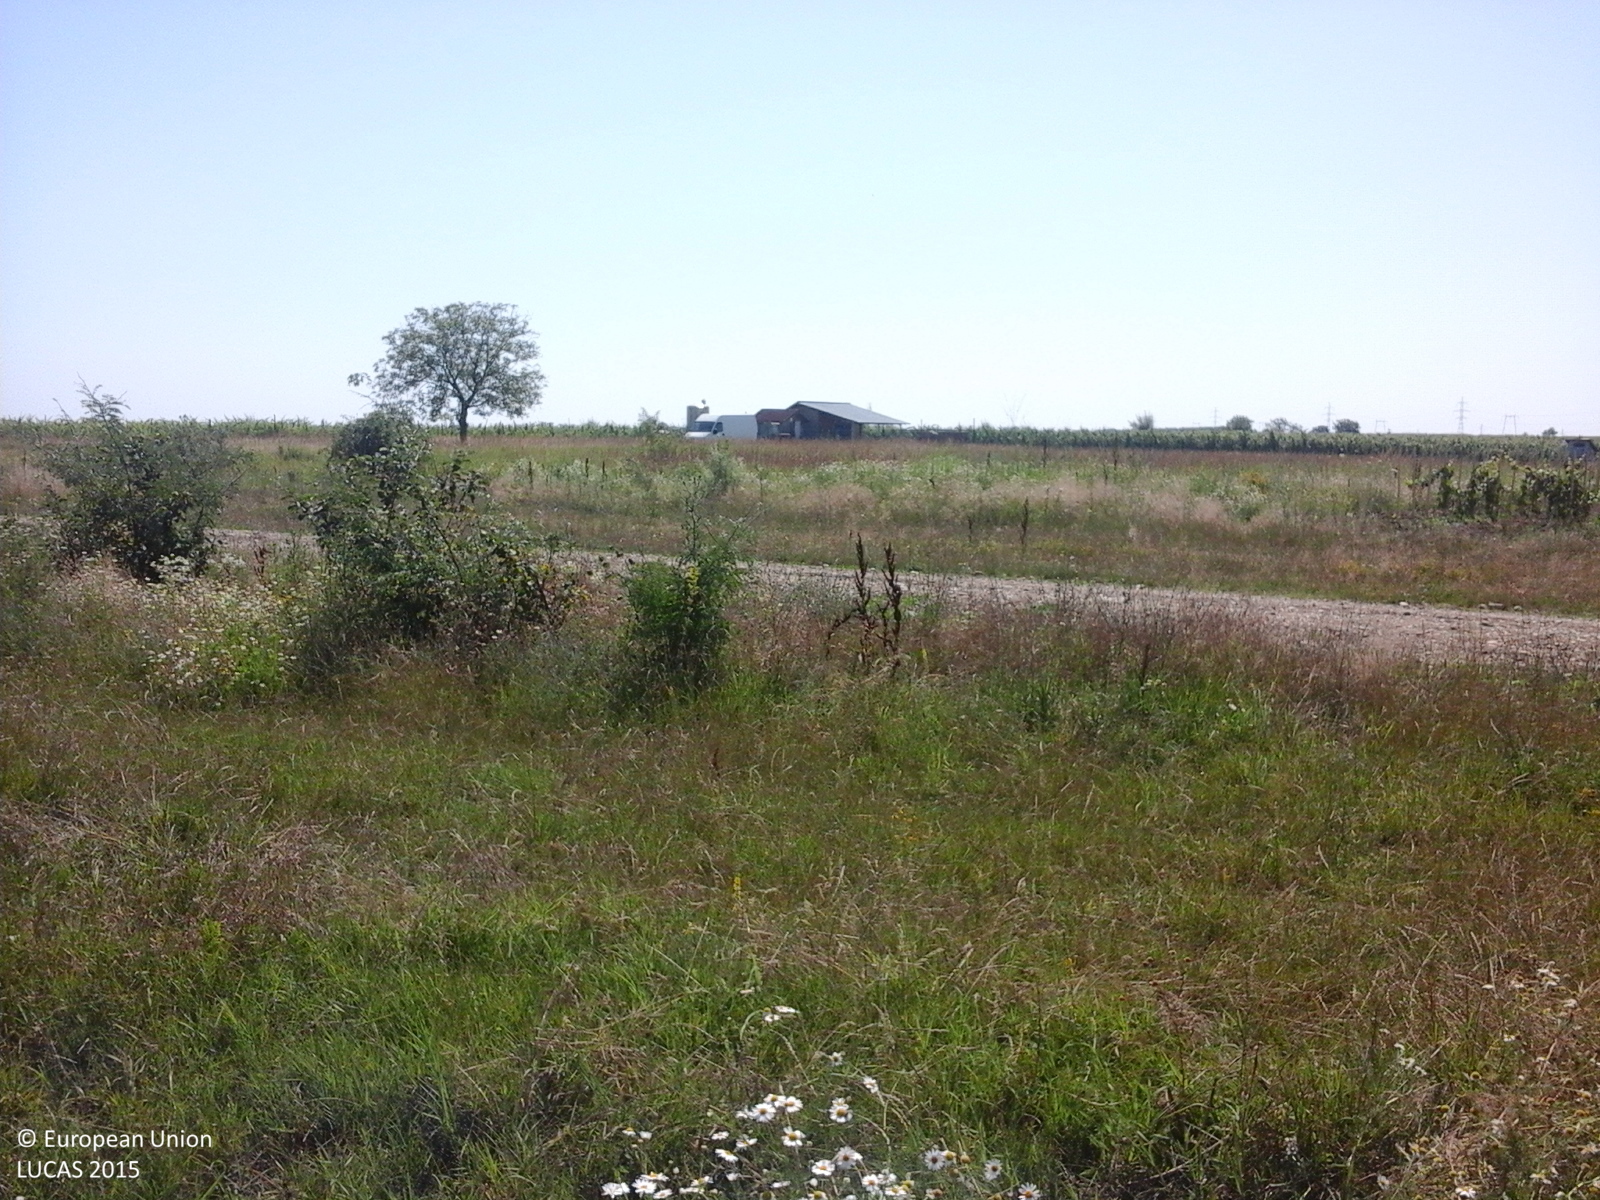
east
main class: Grassland
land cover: Spontaneously vegetated surfaces
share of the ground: > 75 %
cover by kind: herbaceous plants 100 %
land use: Agriculture (excluding fallow land and kitchen gardens)
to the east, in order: Spontaneously vegetated surfaces; Tracks; Spontaneously vegetated surfaces; Single bushes/trees; Tracks; Spontaneously vegetated surfaces; Vineyards; Tracks; Vineyards; Ditches and canals; Tracks; Ditches and canals; Vineyards
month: July
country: RO
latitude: 44.4893
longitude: 24.1608
